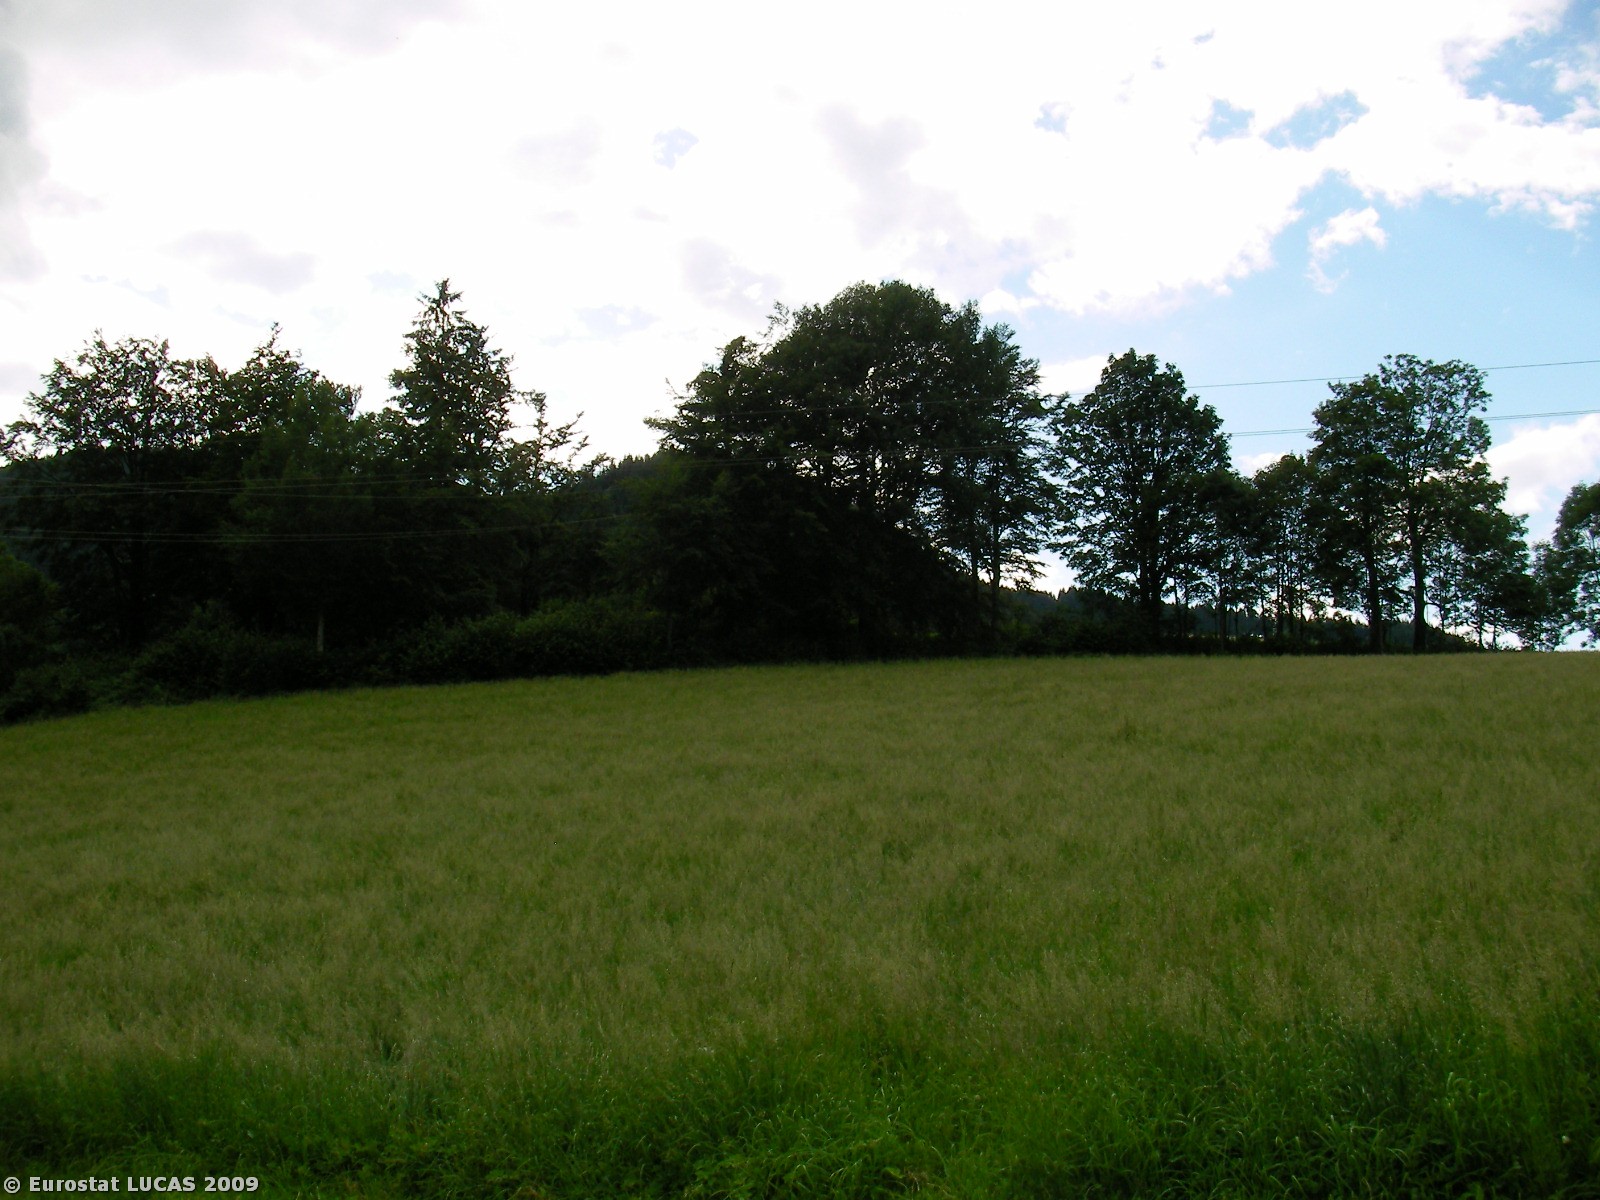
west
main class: Grassland
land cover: Grassland without tree/shrub cover
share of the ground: > 75 %
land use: Agriculture (excluding fallow land and kitchen gardens)
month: July
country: AT
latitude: 47.4120
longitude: 15.6336
